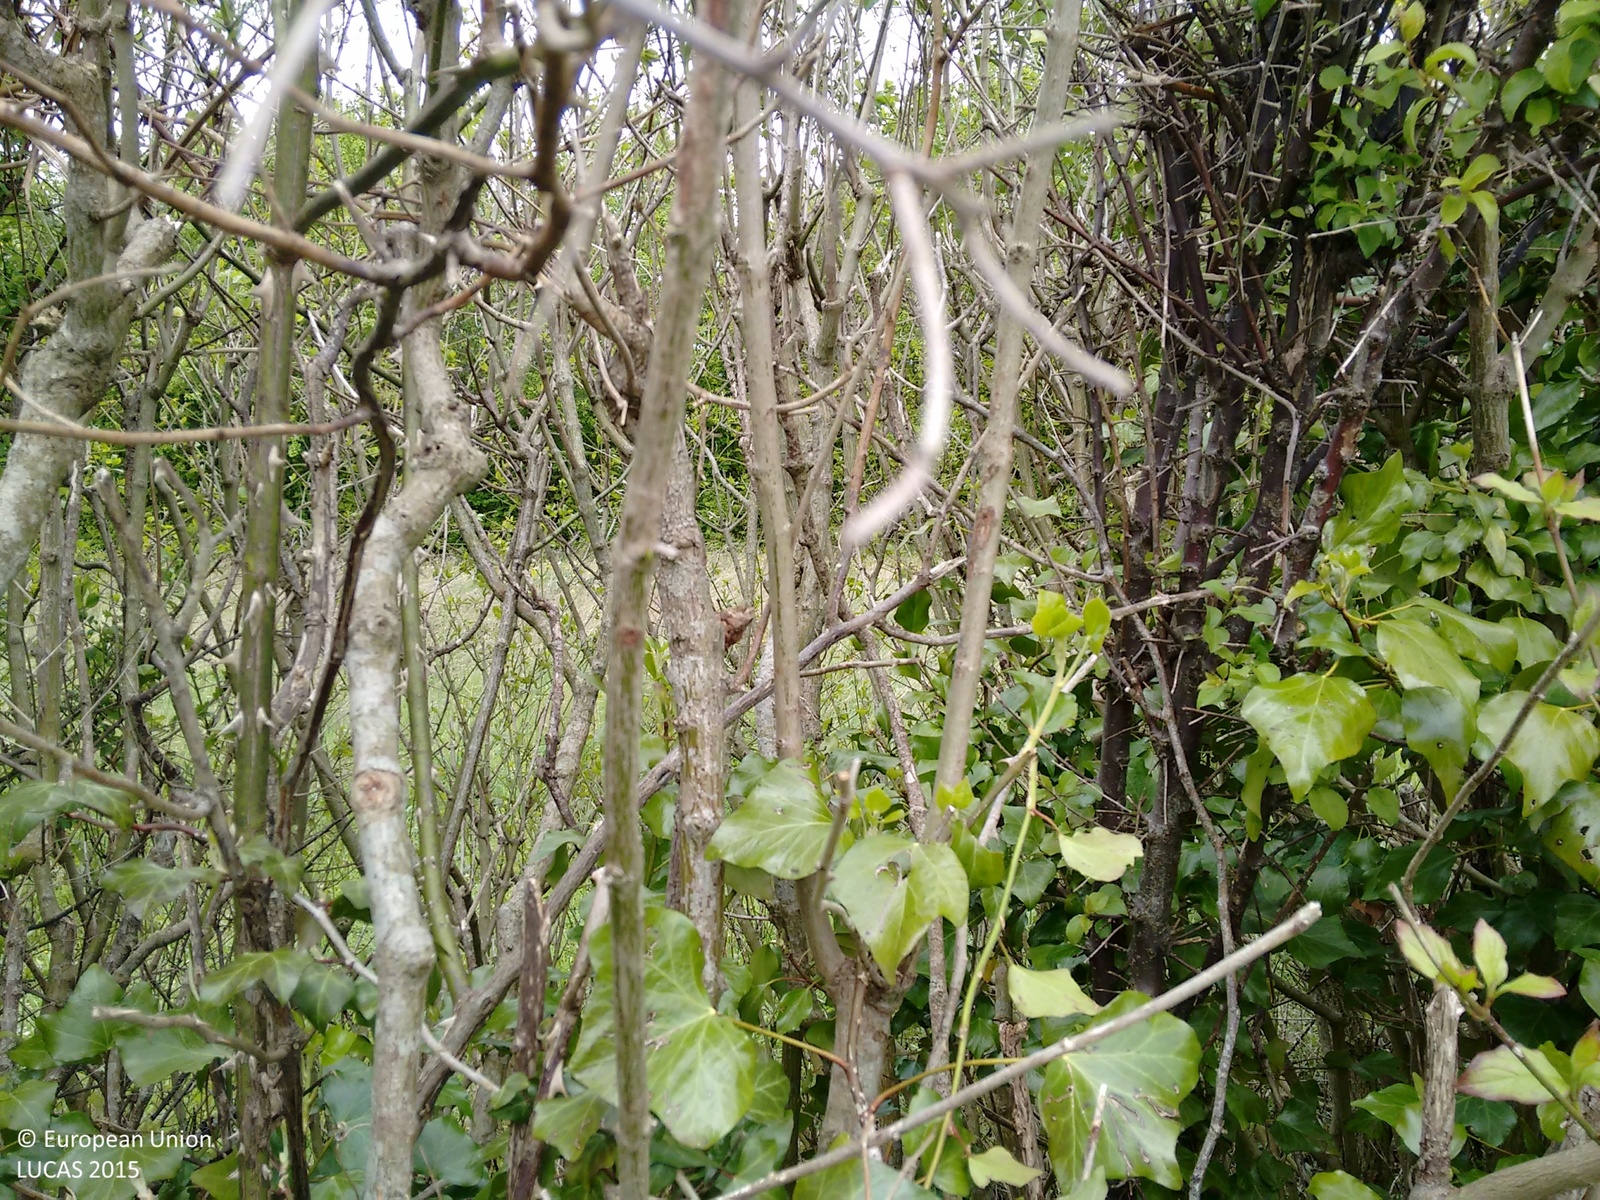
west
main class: Grassland
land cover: Grassland without tree/shrub cover
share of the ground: > 75 %
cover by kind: herbaceous plants 100 %
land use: Agriculture (excluding fallow land and kitchen gardens)
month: May
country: GB
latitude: 51.0733
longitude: -1.4829
